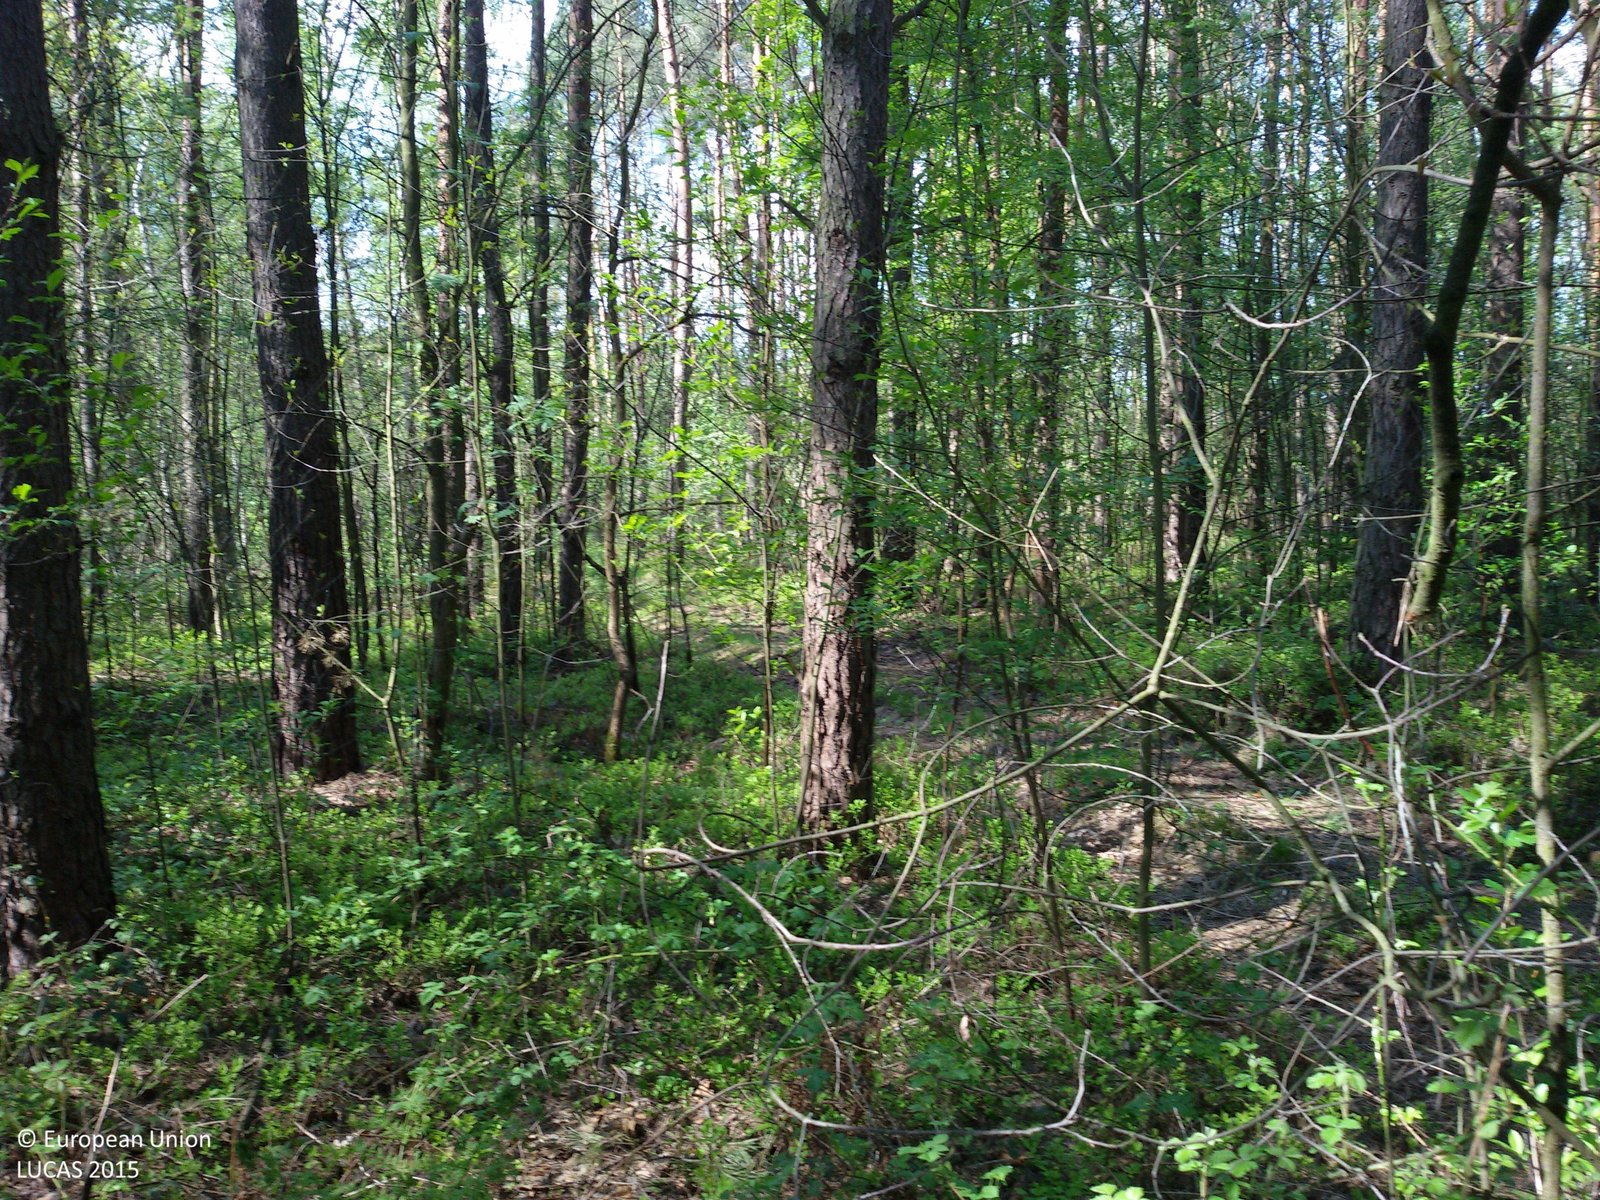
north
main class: Woodland
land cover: Pine dominated mixed woodland
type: hemiboreal forest and nemoral coniferous forest and mixed broadleaved-coniferous forest
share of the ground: > 75 %
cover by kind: coniferous forest trees 65 %, broadleaved forest trees 25 %, shrubs 5 %, herbaceous plants 5 %
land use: Forestry
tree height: > 5 m
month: May
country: PL
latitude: 51.8761
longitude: 21.0703
